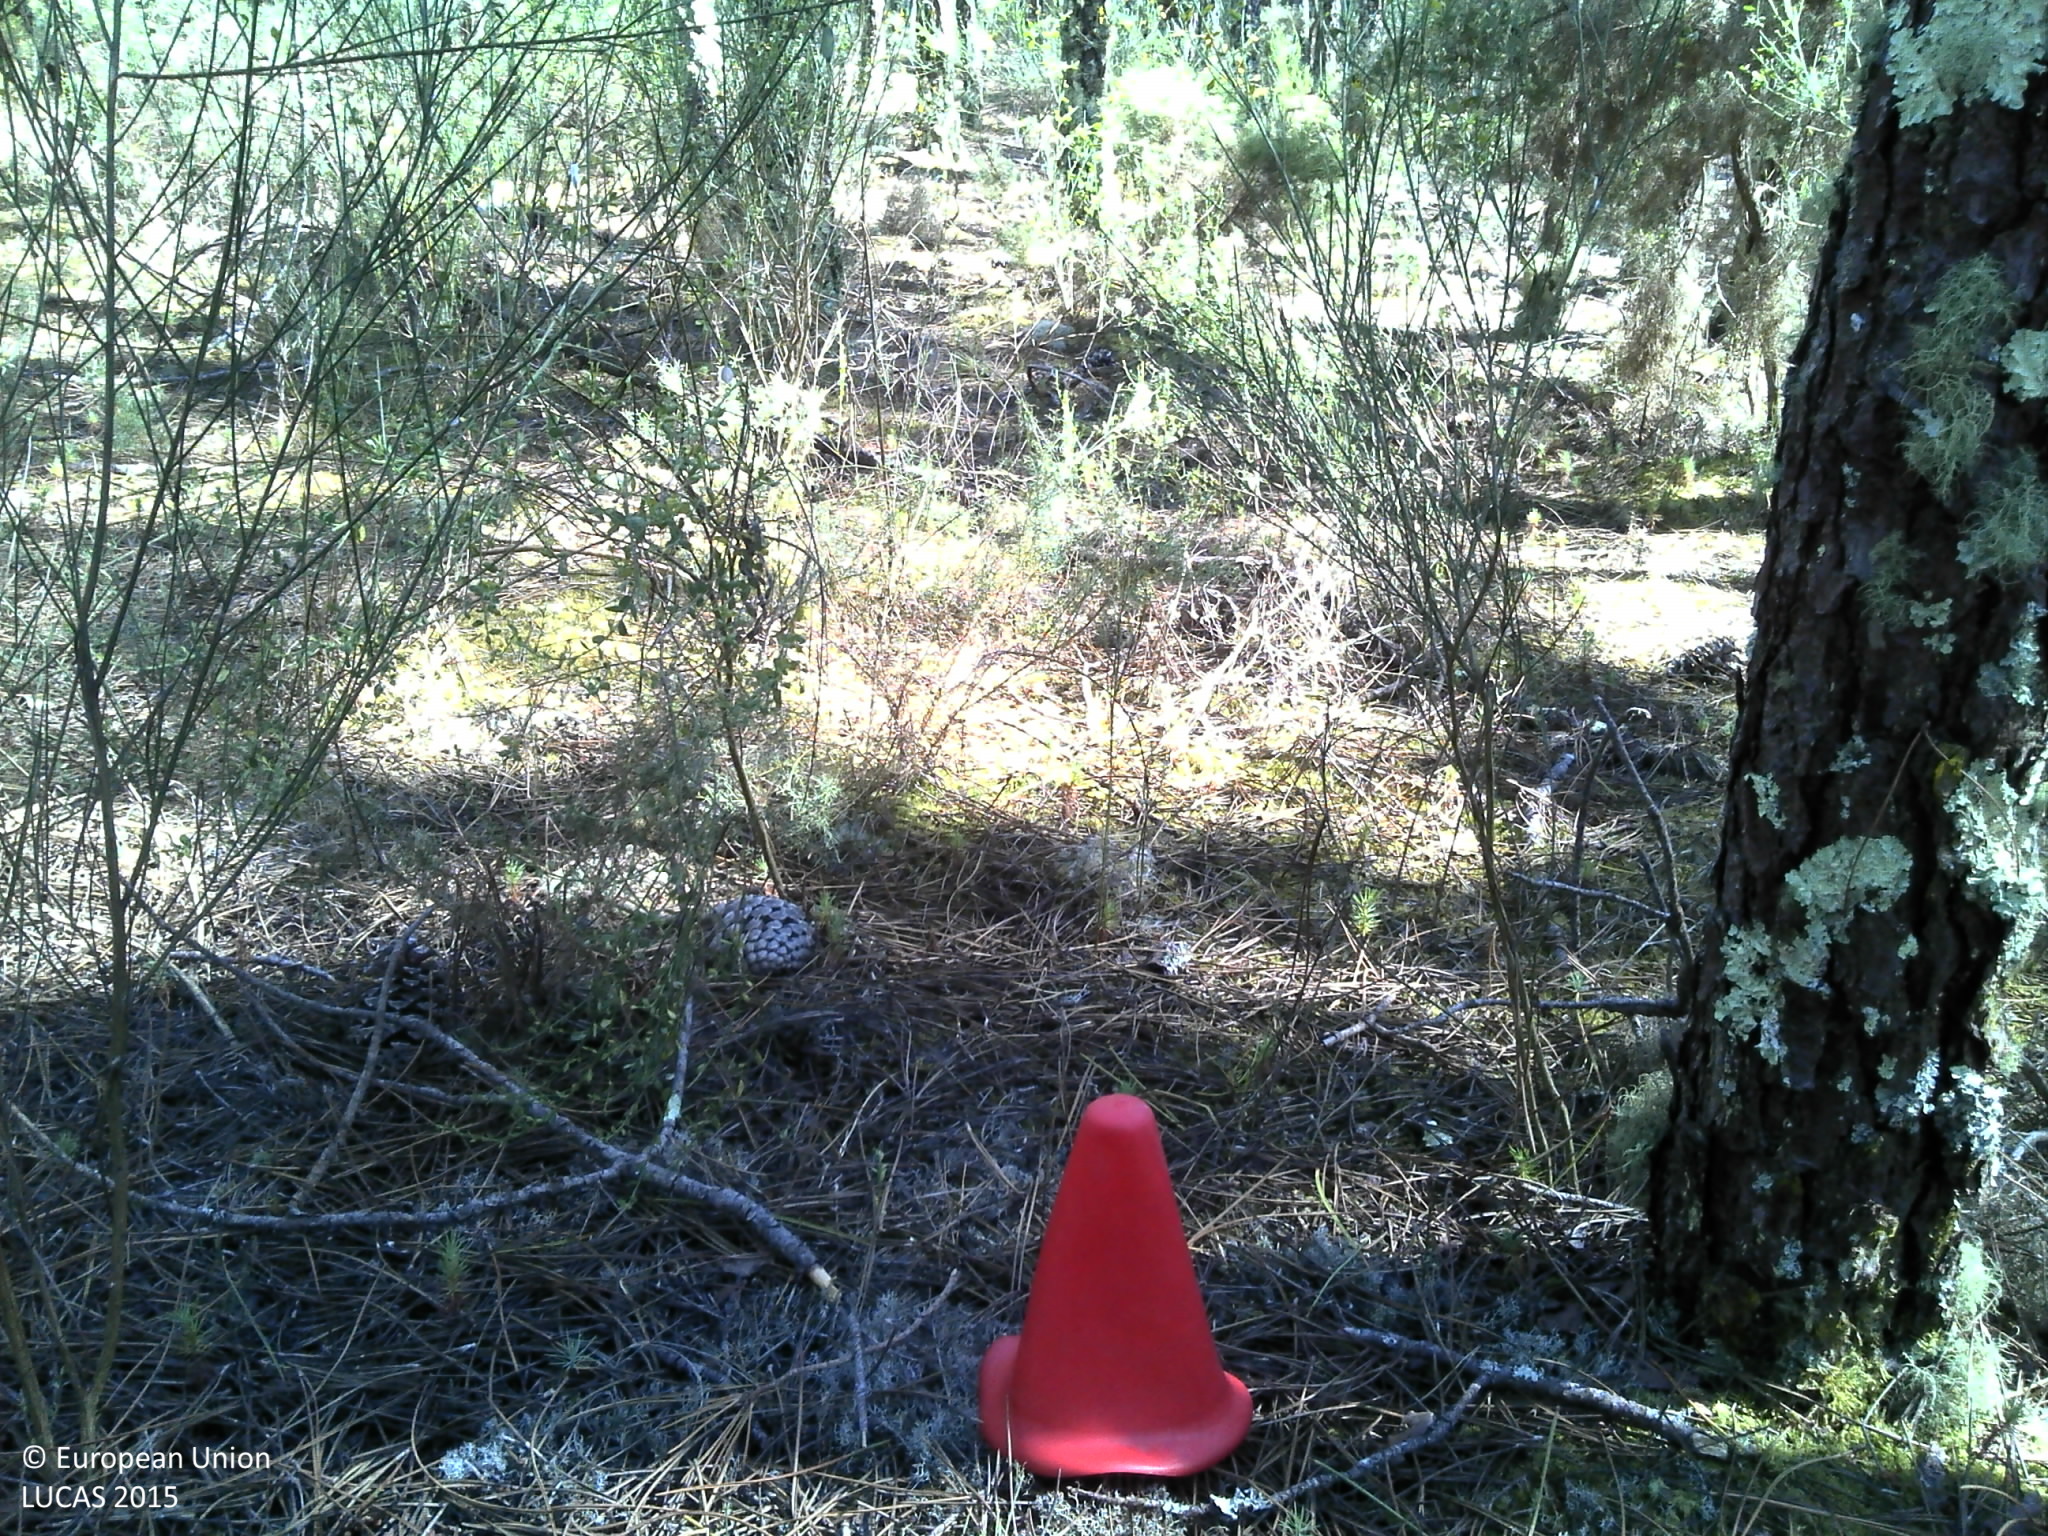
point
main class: Woodland
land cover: Pine dominated coniferous woodland
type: coniferous forest of the mediterranean region
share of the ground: 50 - 75 %
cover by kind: coniferous forest trees 75 %, unconsolidated bare surface 15 %, shrubs 10 %
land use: Forestry
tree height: > 5 m
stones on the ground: < 10 %
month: May
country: PT
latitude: 40.5742
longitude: -8.7274
